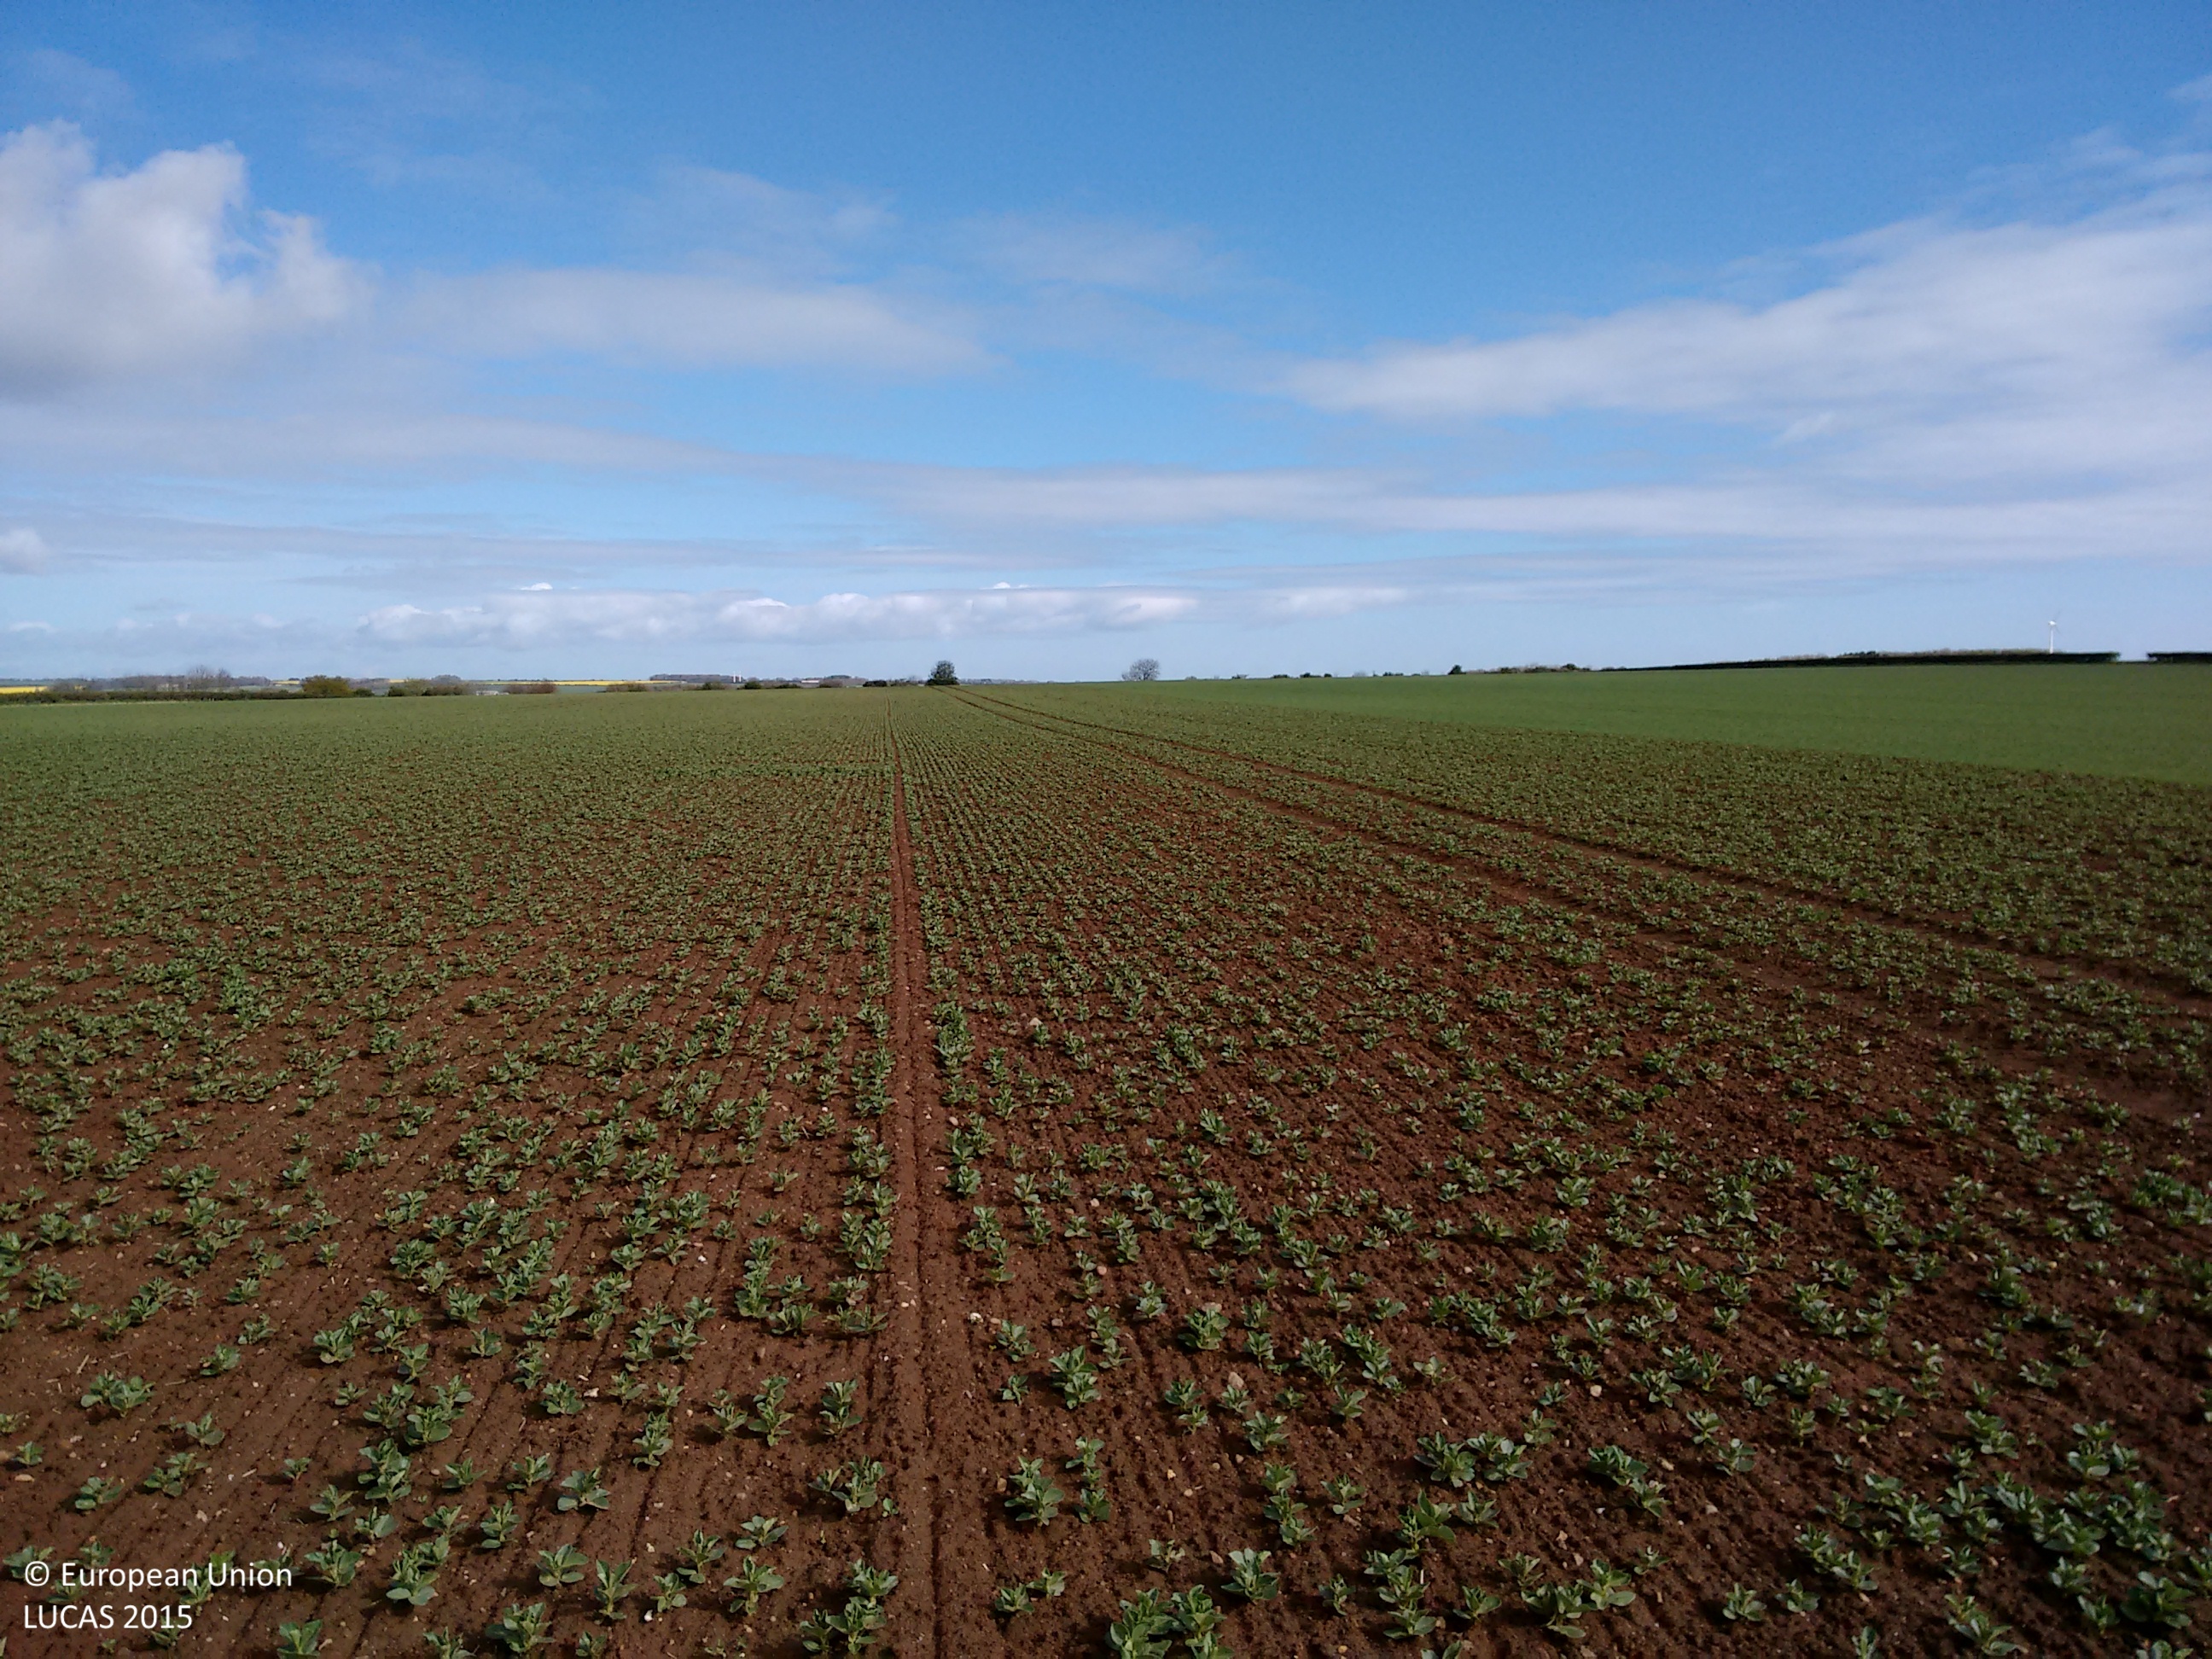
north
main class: Cropland
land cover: Dry pulses
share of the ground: 10 - 25 %
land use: Agriculture (excluding fallow land and kitchen gardens)
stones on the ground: < 10 %
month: May
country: GB
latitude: 54.0635
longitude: -0.3480
